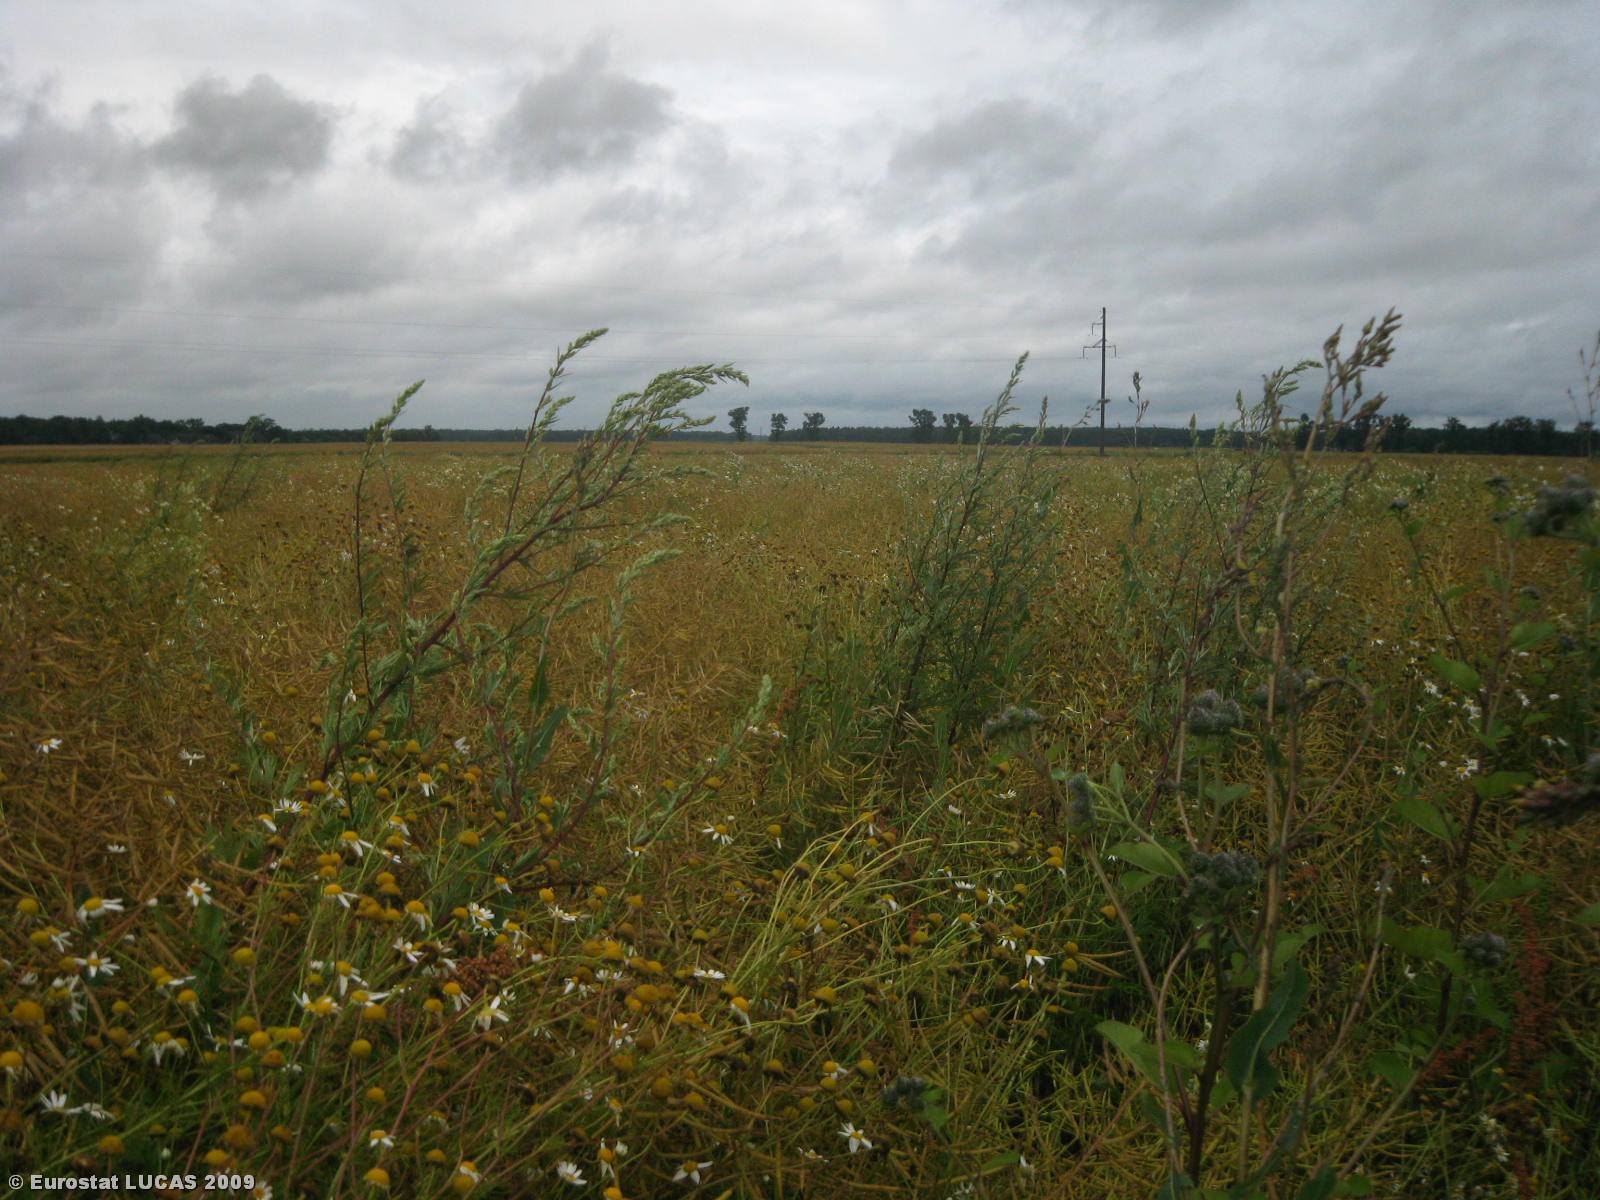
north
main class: Cropland
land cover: Rape and turnip rape
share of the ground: > 75 %
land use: Agriculture (excluding fallow land and kitchen gardens)
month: July
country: LT
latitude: 55.5088
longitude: 23.8135
